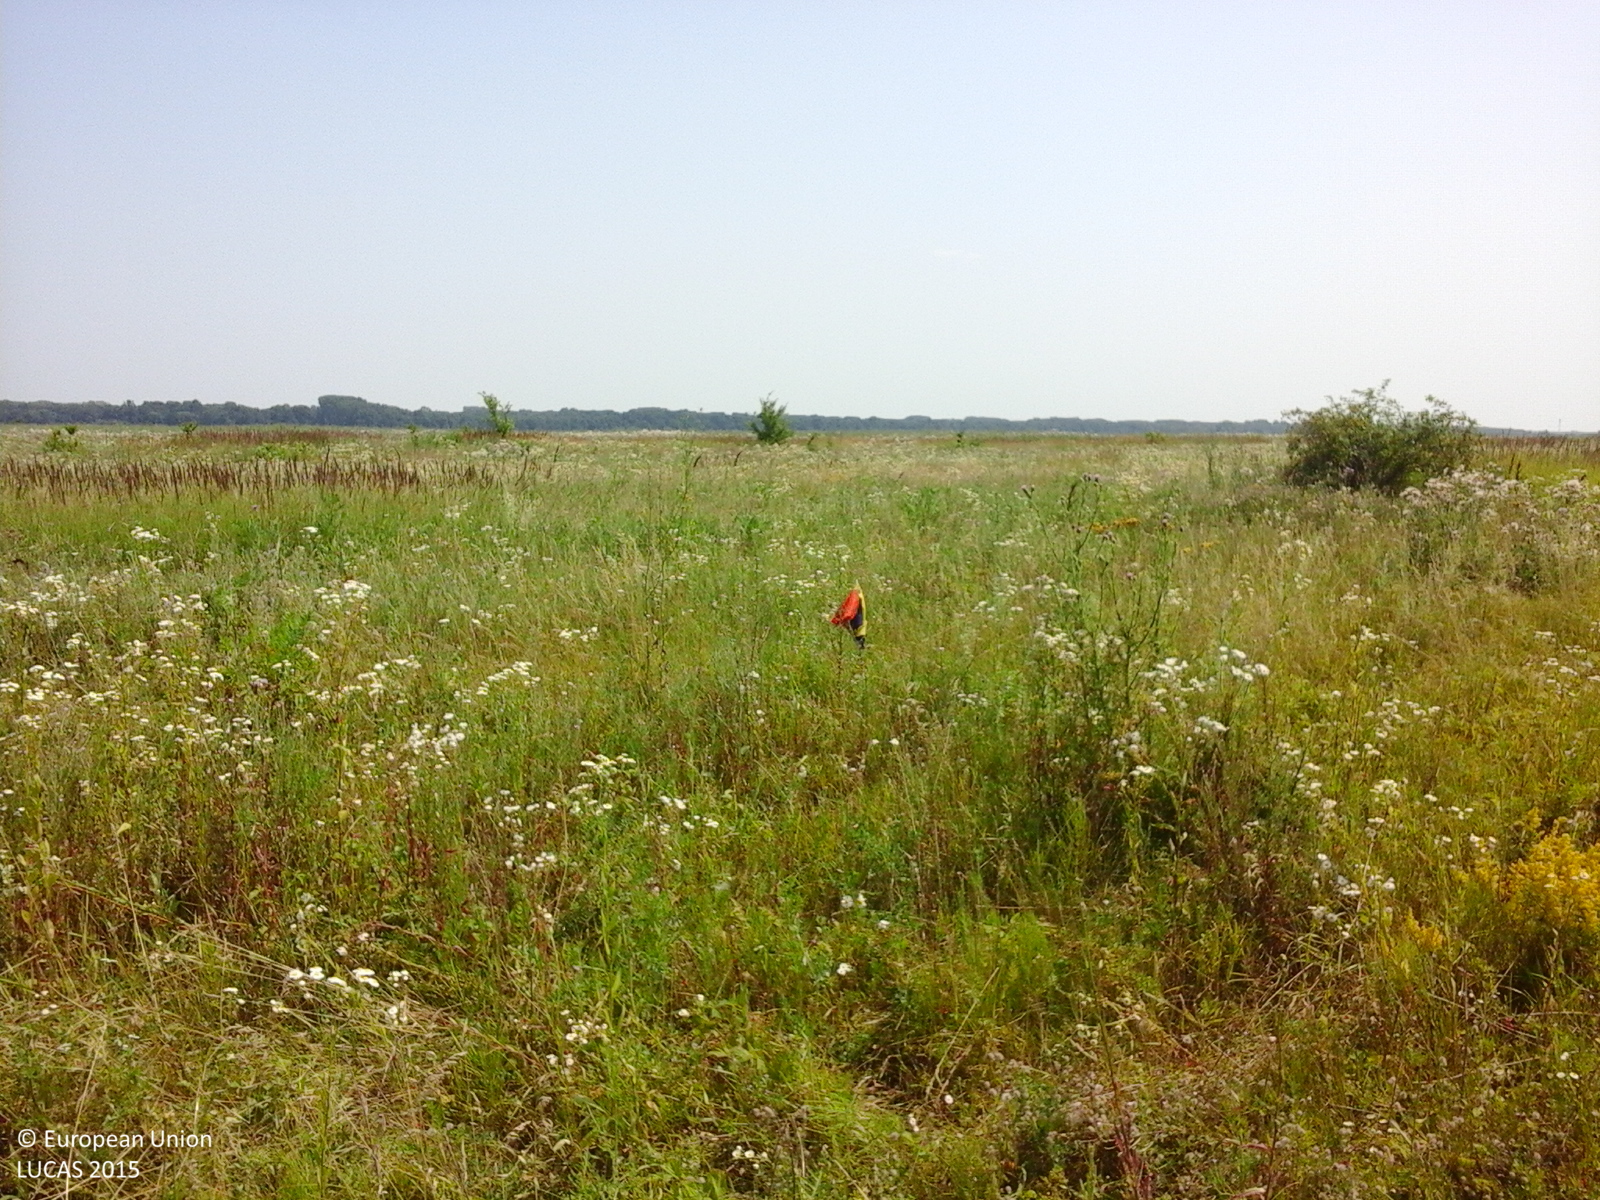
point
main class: Grassland
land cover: Spontaneously vegetated surfaces
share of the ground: > 75 %
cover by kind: herbaceous plants 100 %
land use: Fallow land
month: July
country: RO
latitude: 44.5497
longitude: 25.6412
